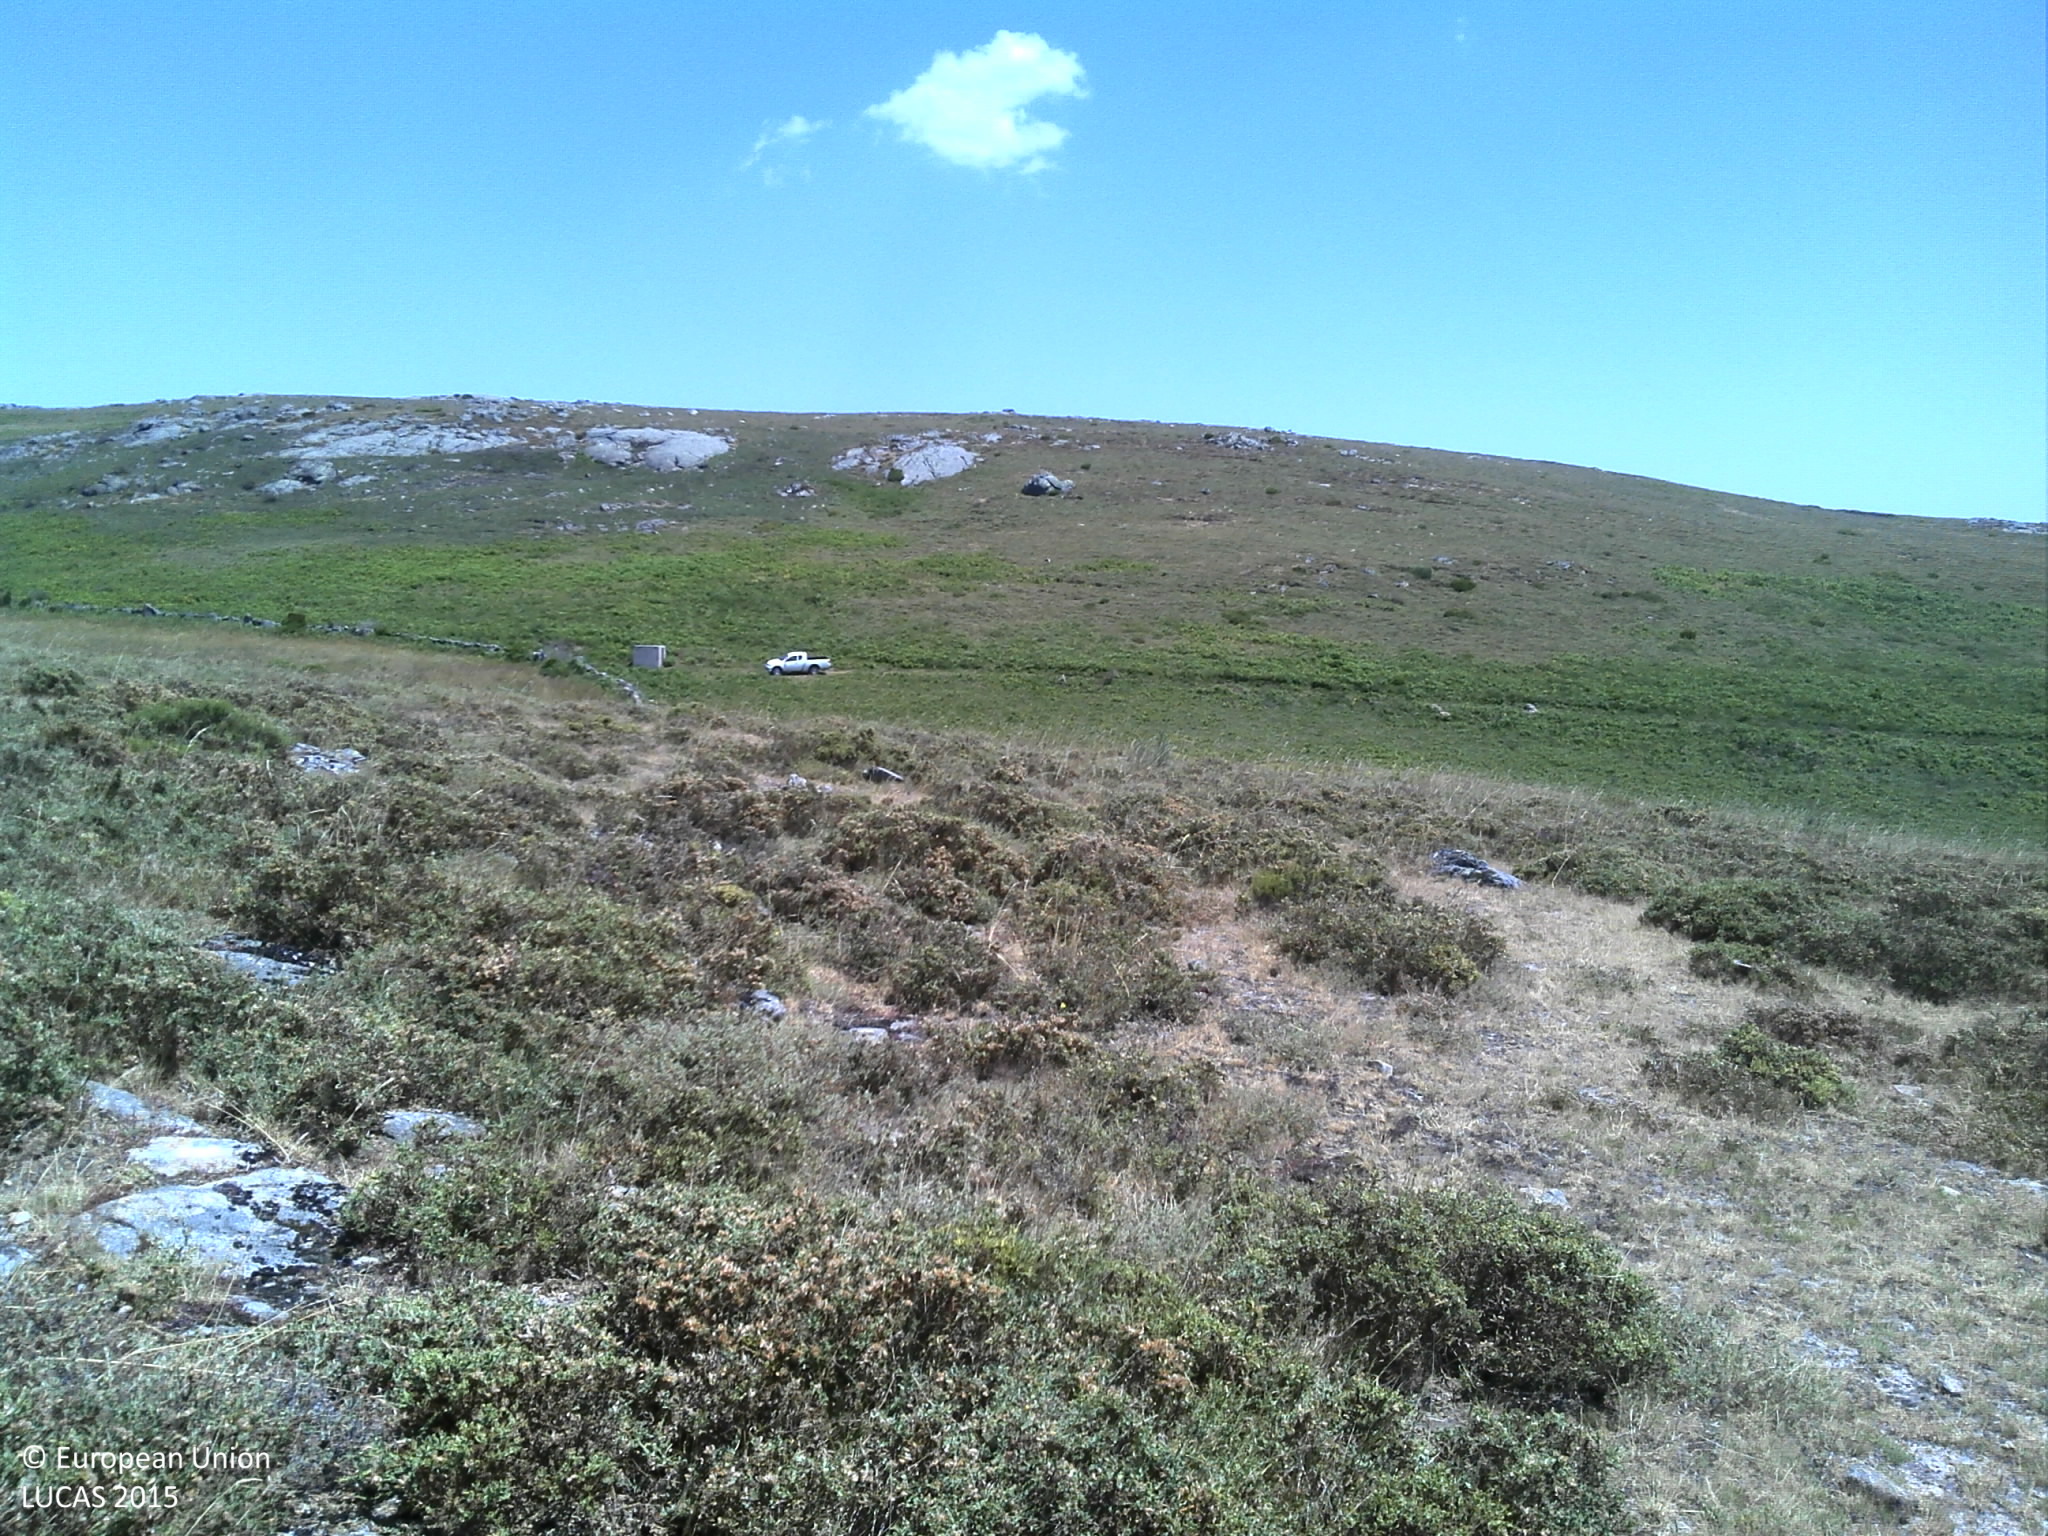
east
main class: Shrubland
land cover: Shrubland without tree cover
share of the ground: 50 - 75 %
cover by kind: shrubs 75 %, herbaceous plants 15 %, unconsolidated bare surface 10 %
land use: Agriculture (excluding fallow land and kitchen gardens)
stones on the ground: 25 - 50 %
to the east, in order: Shrubland without tree cover; Rivers and streams; Shrubland without tree cover; Rock outcrops; Shrubland without tree cover
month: July
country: PT
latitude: 41.8673
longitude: -7.9395
